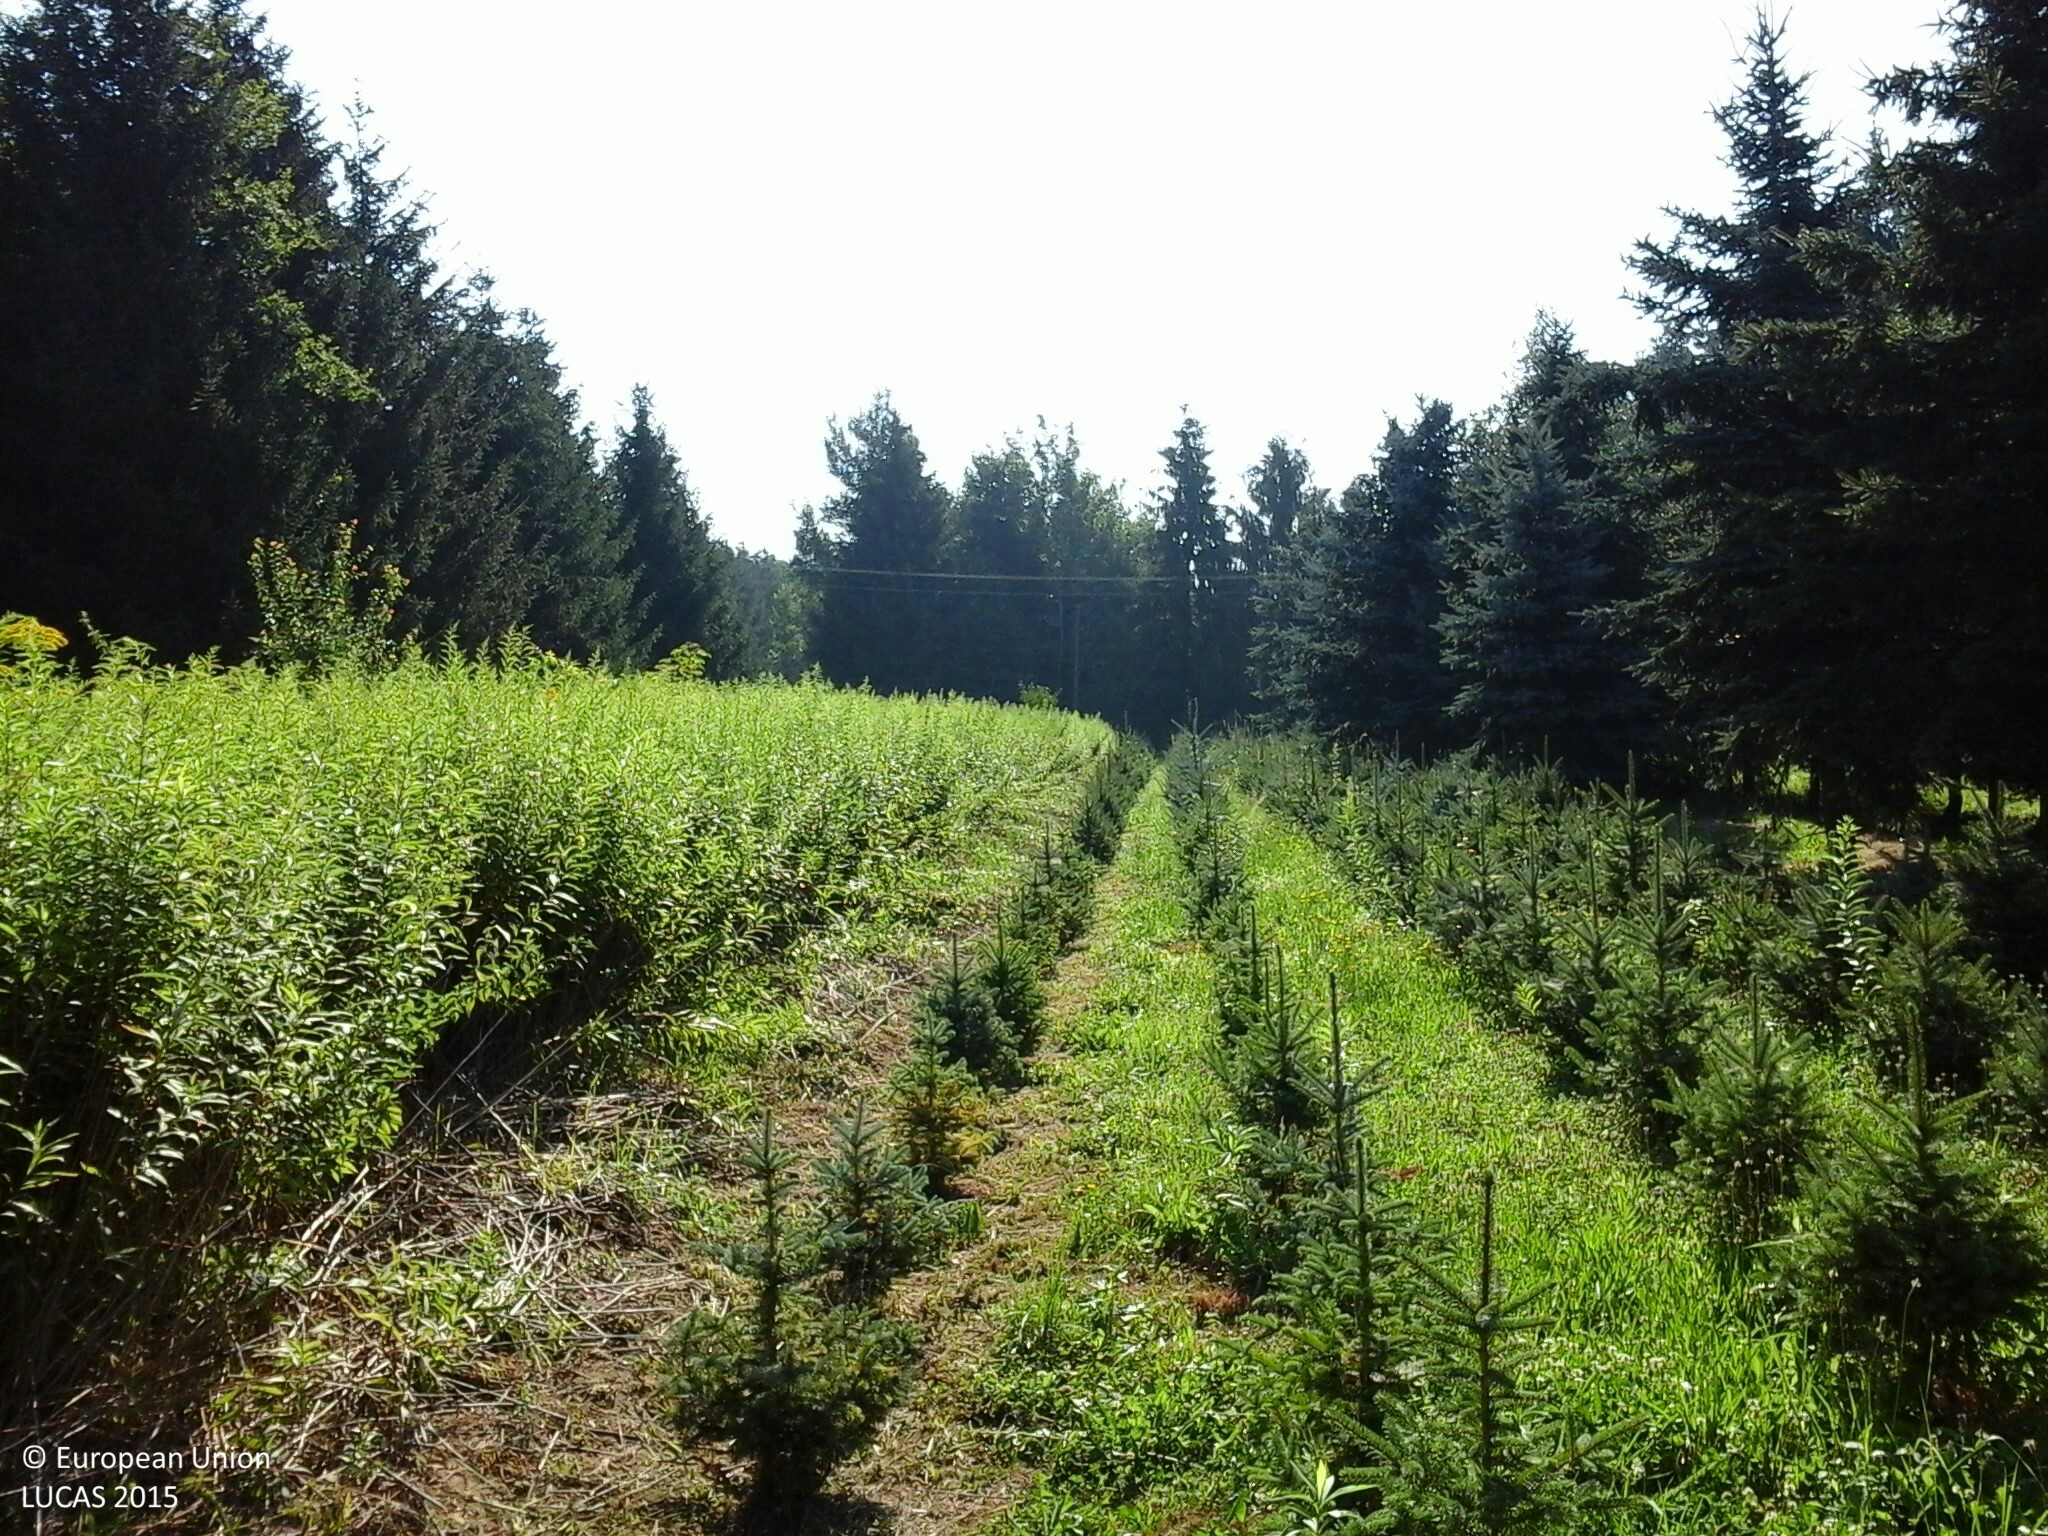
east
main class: Cropland
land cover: Nurseries
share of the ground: 25 - 50 %
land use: Forestry
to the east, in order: Nurseries; Spontaneously vegetated surfaces; Electric lines; Ditches and canals; Grass margins; Paved roads, cycling and walking lanes; Grass margins; Ditches and canals; Grass margins; Electric lines; Pine dominated coniferous woodland; Grassland without tree/shrub cover; Broadleaved woodland
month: July
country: HU
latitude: 46.9721
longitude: 16.4034
